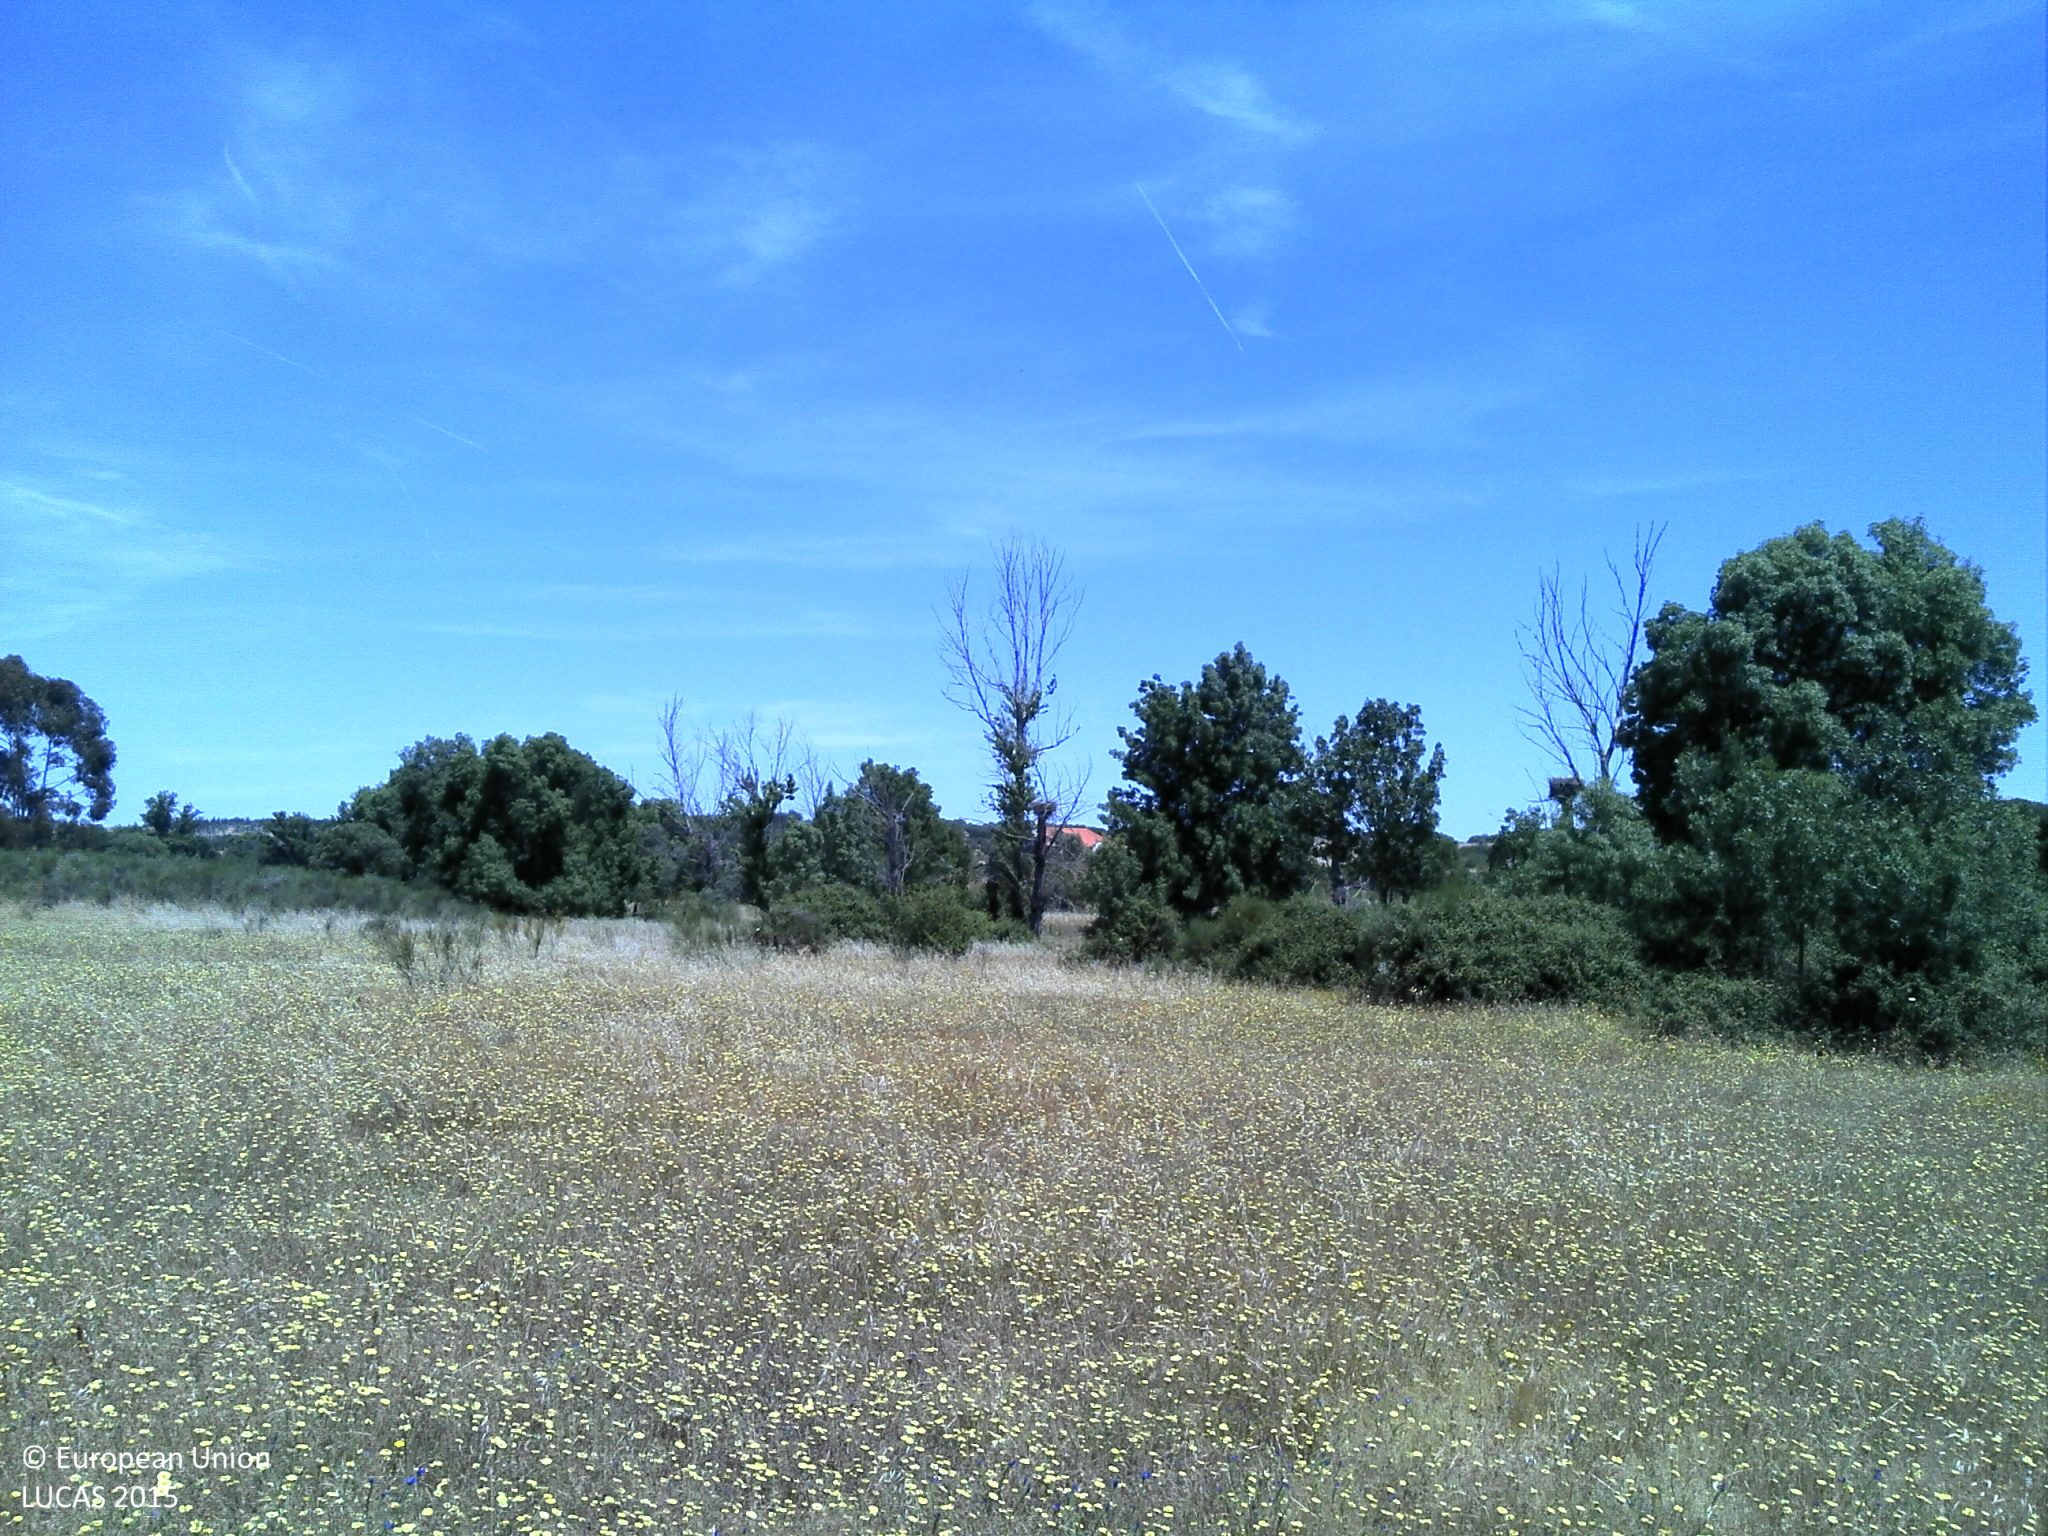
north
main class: Grassland
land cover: Grassland without tree/shrub cover
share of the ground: 50 - 75 %
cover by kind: herbaceous plants 60 %, unconsolidated bare surface 40 %
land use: Agriculture (excluding fallow land and kitchen gardens)
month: May
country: PT
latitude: 39.2404
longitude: -7.6685
